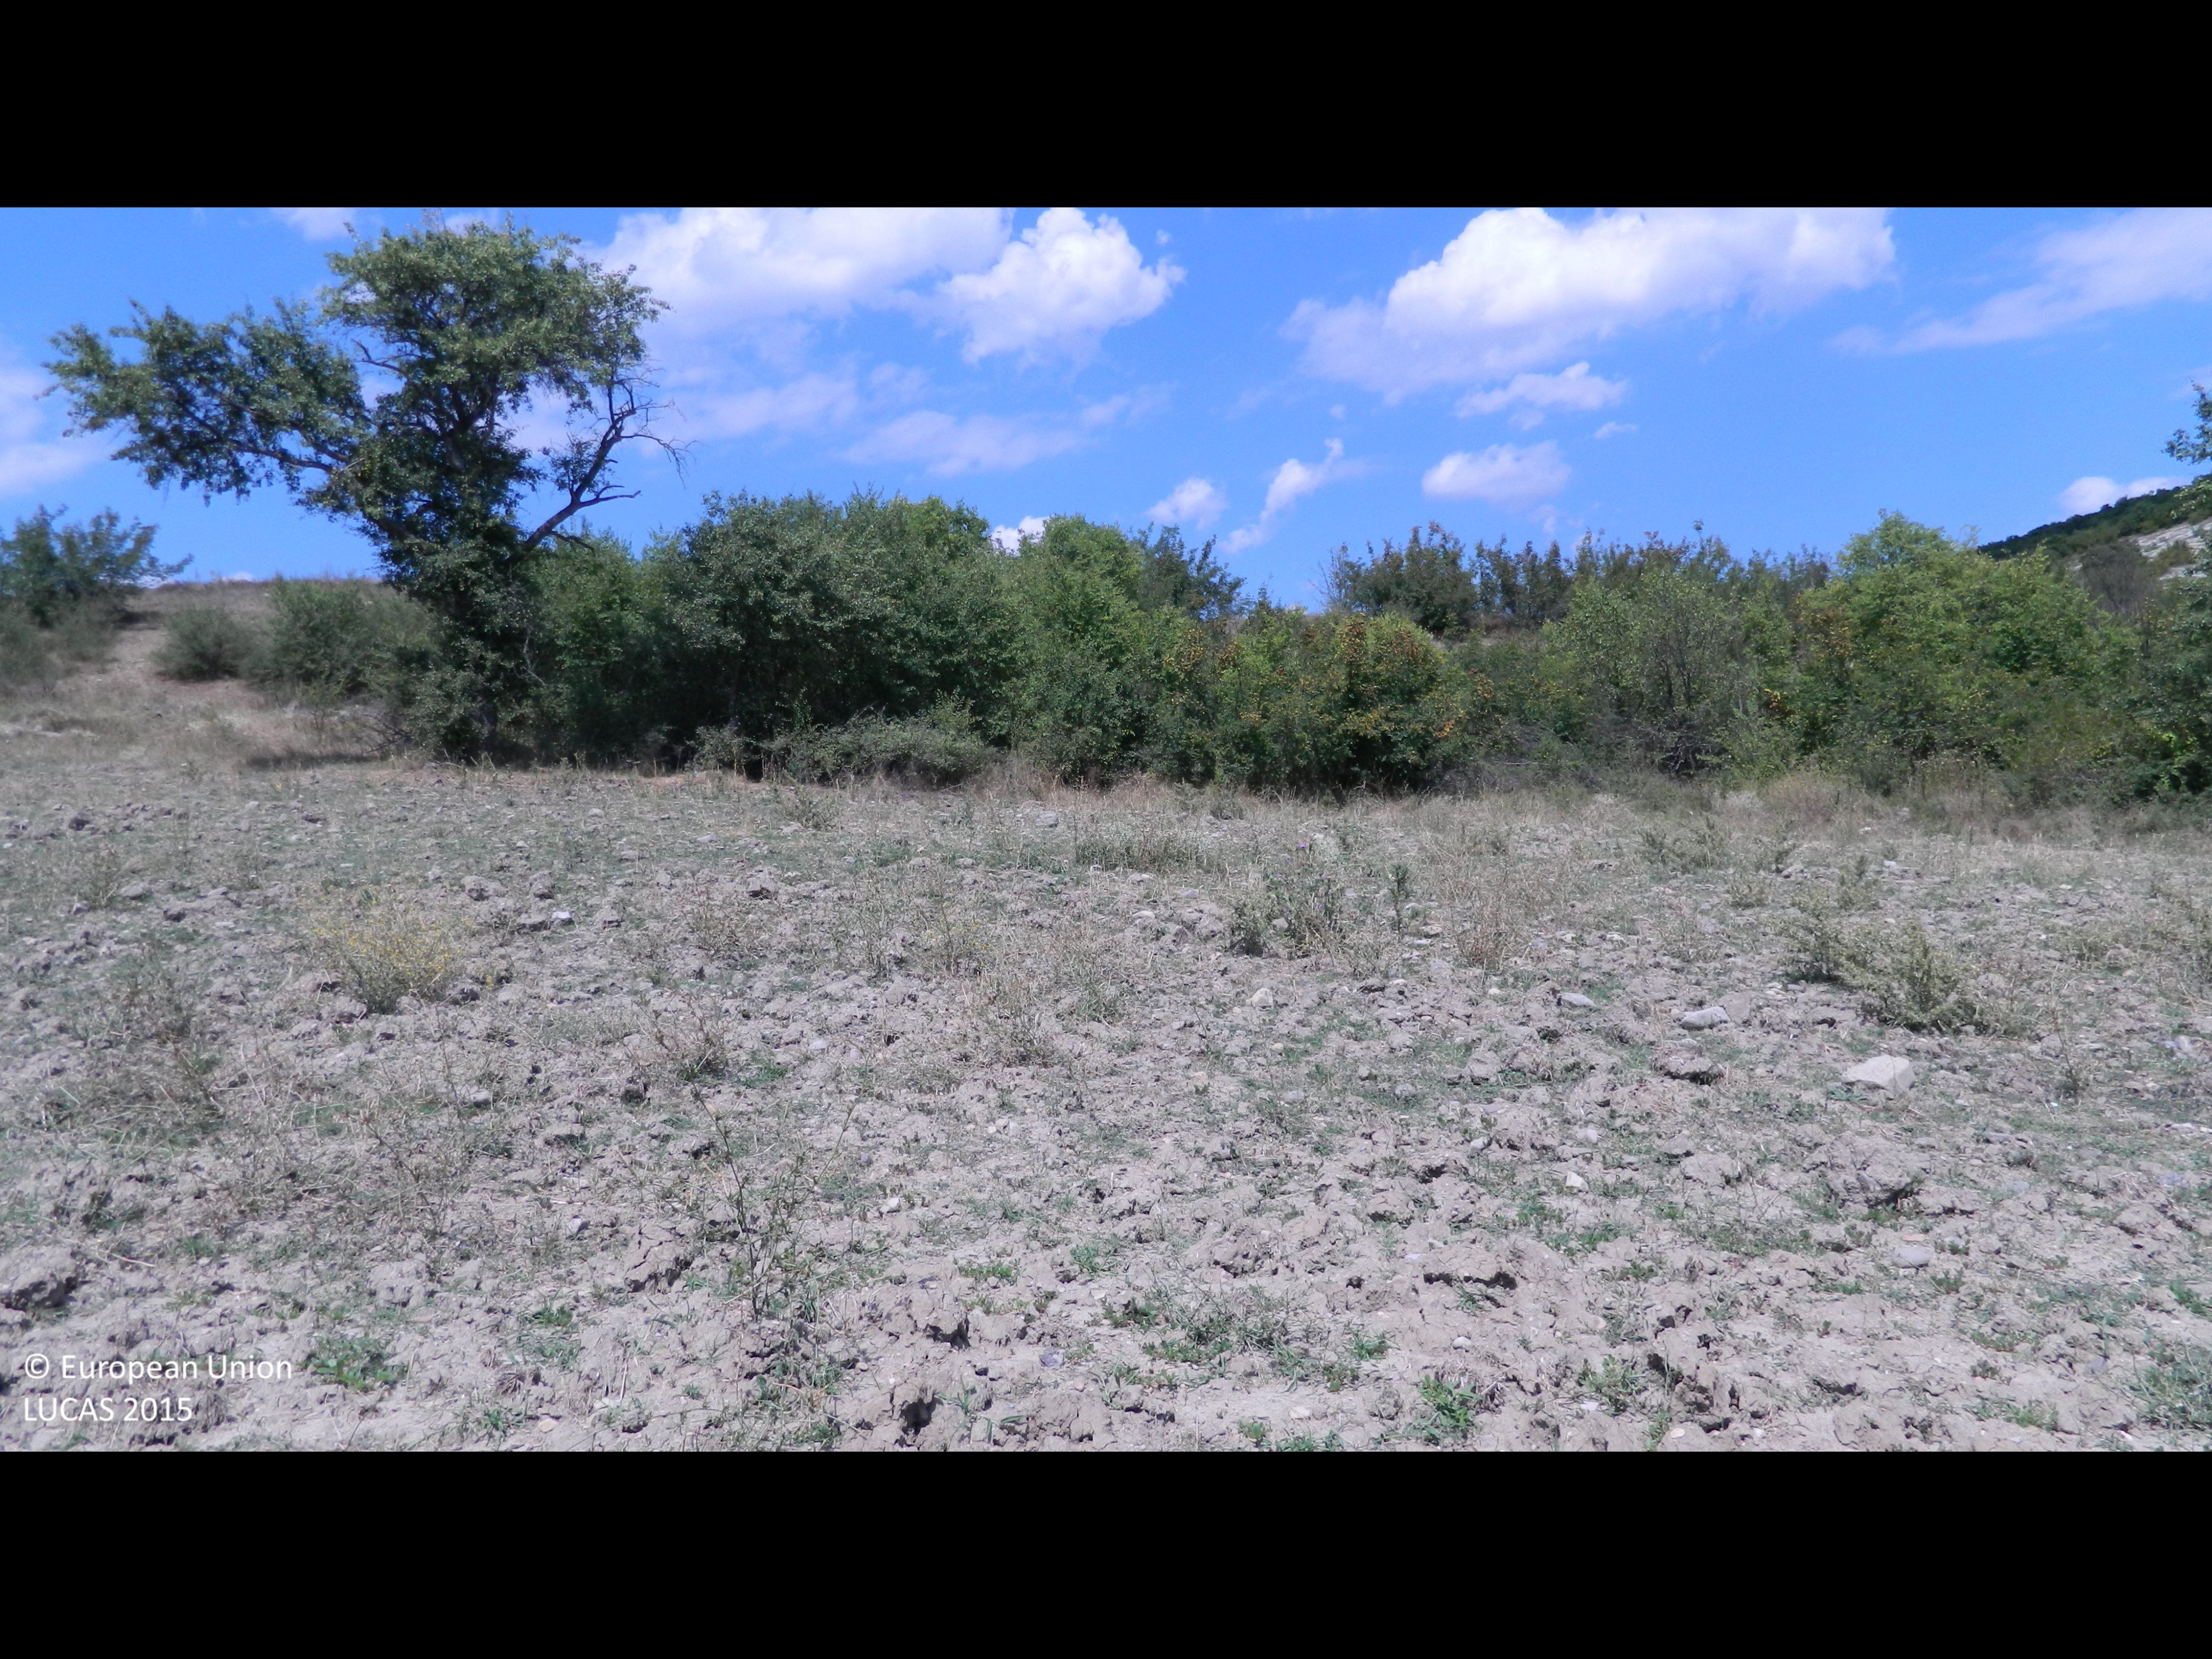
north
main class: Cropland
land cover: Other cereals
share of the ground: < 10 %
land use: Agriculture (excluding fallow land and kitchen gardens)
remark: Harvested field
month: August
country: BG
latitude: 41.6262
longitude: 25.6784
